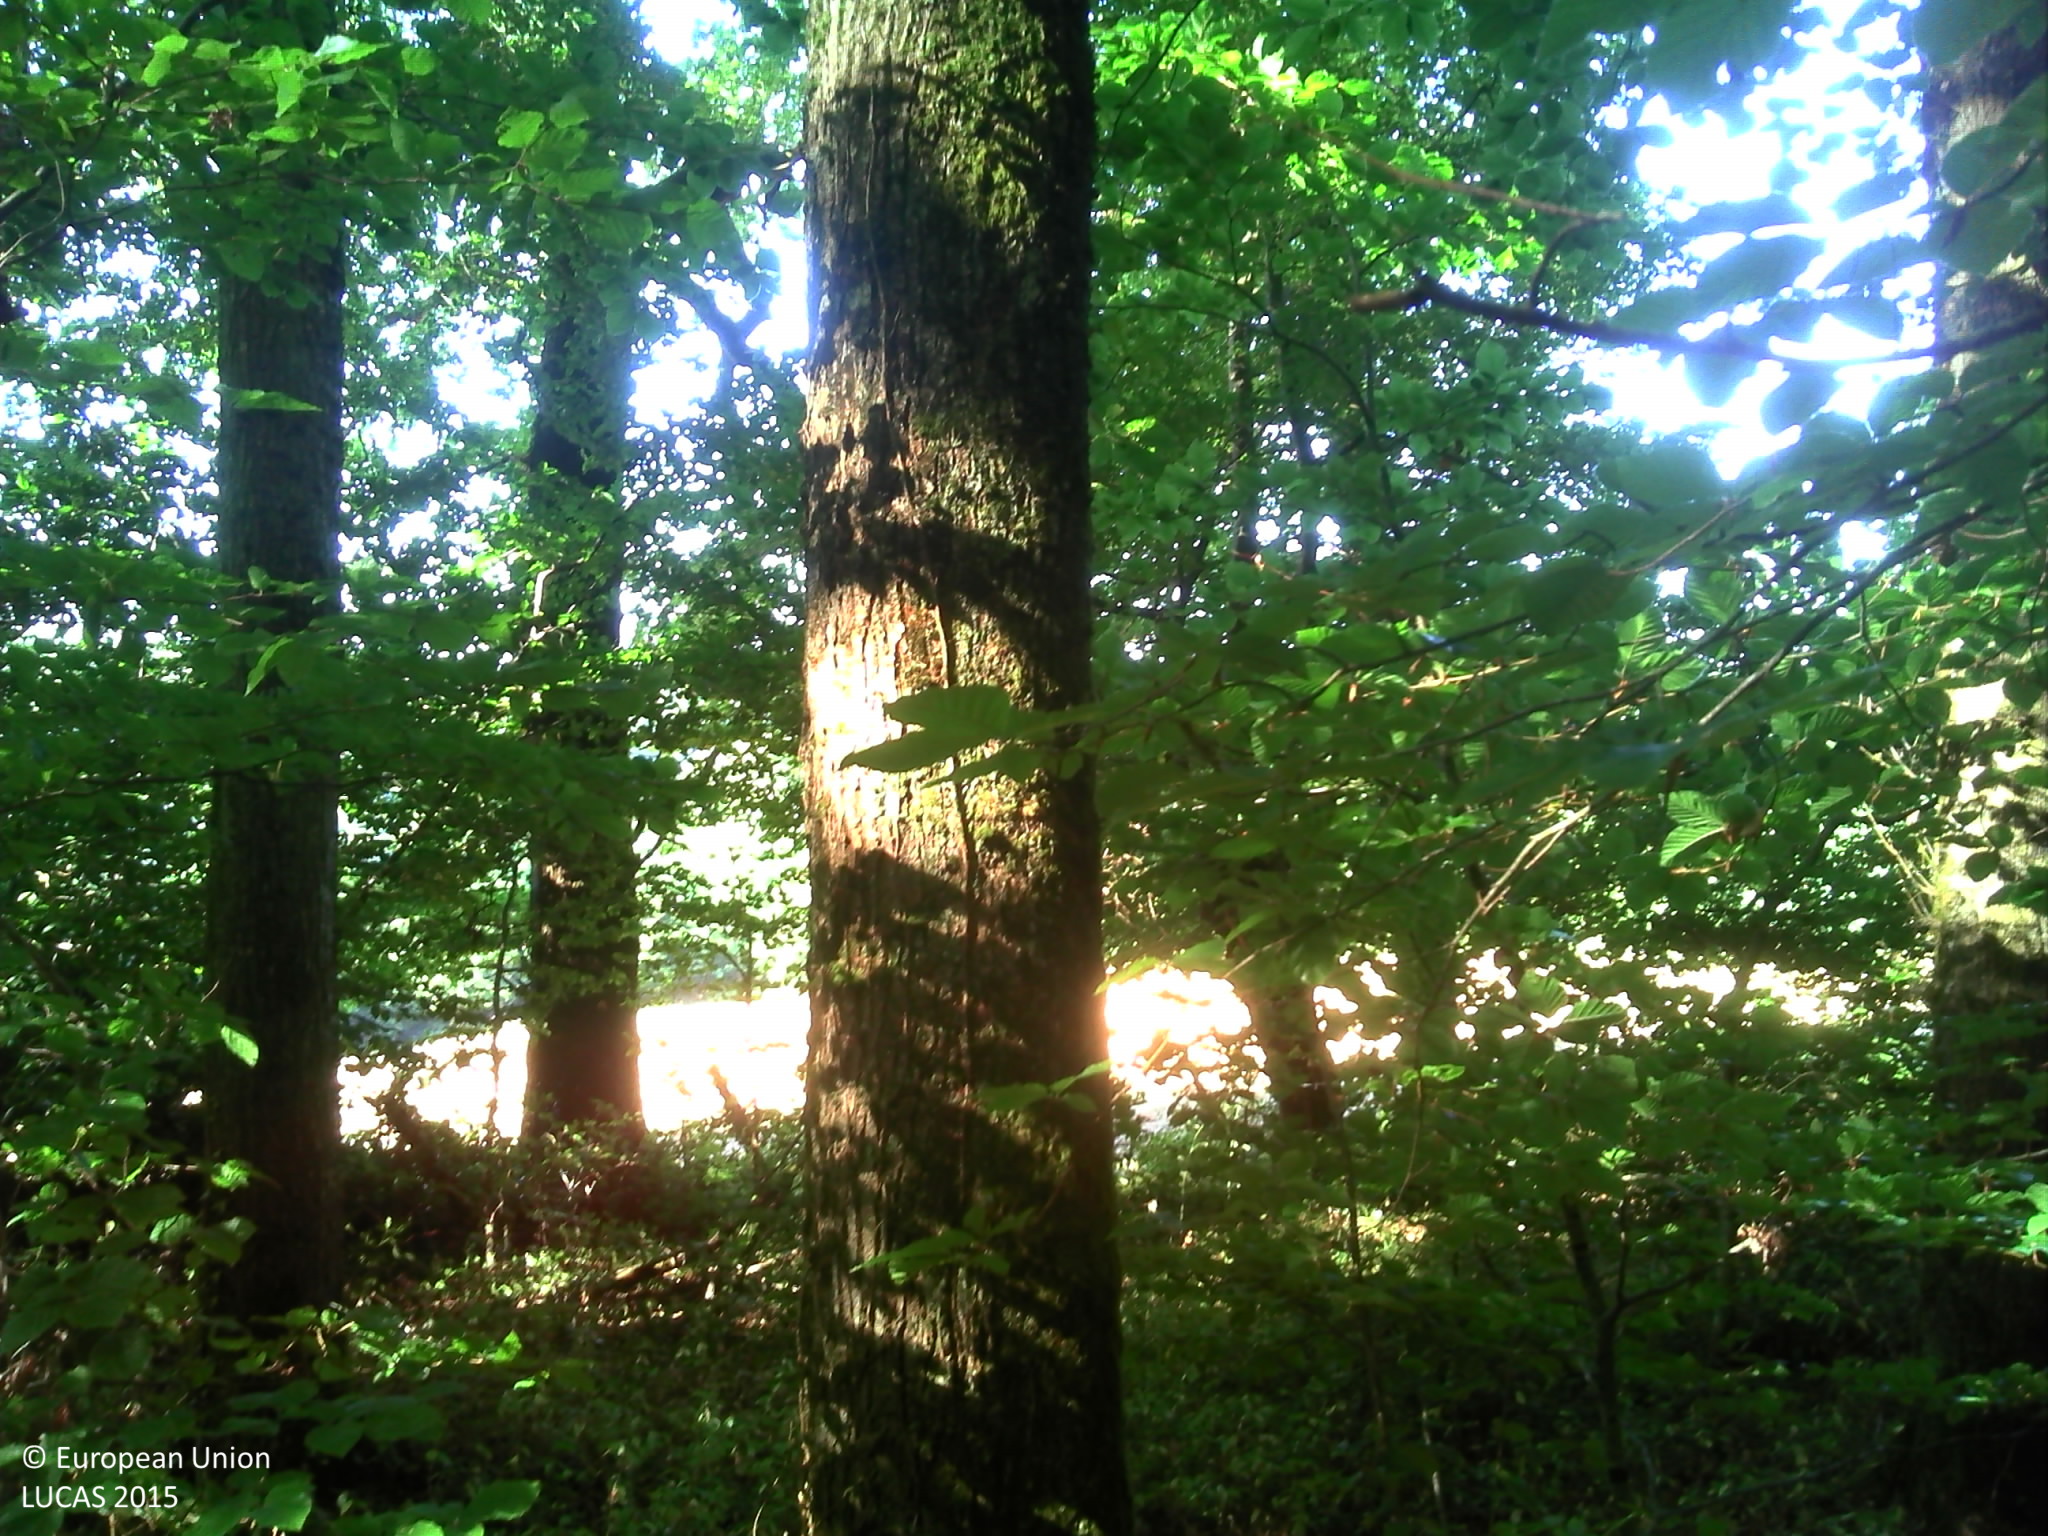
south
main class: Woodland
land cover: Broadleaved woodland
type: acidophilous oak and oak-birch forest
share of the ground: > 75 %
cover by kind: broadleaved forest trees 40 %, herbaceous plants 20 %, lichens and mosses 20 %, unconsolidated bare surface 20 %
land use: Forestry
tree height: > 5 m
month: July
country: FR
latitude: 45.6828
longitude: 1.4545
